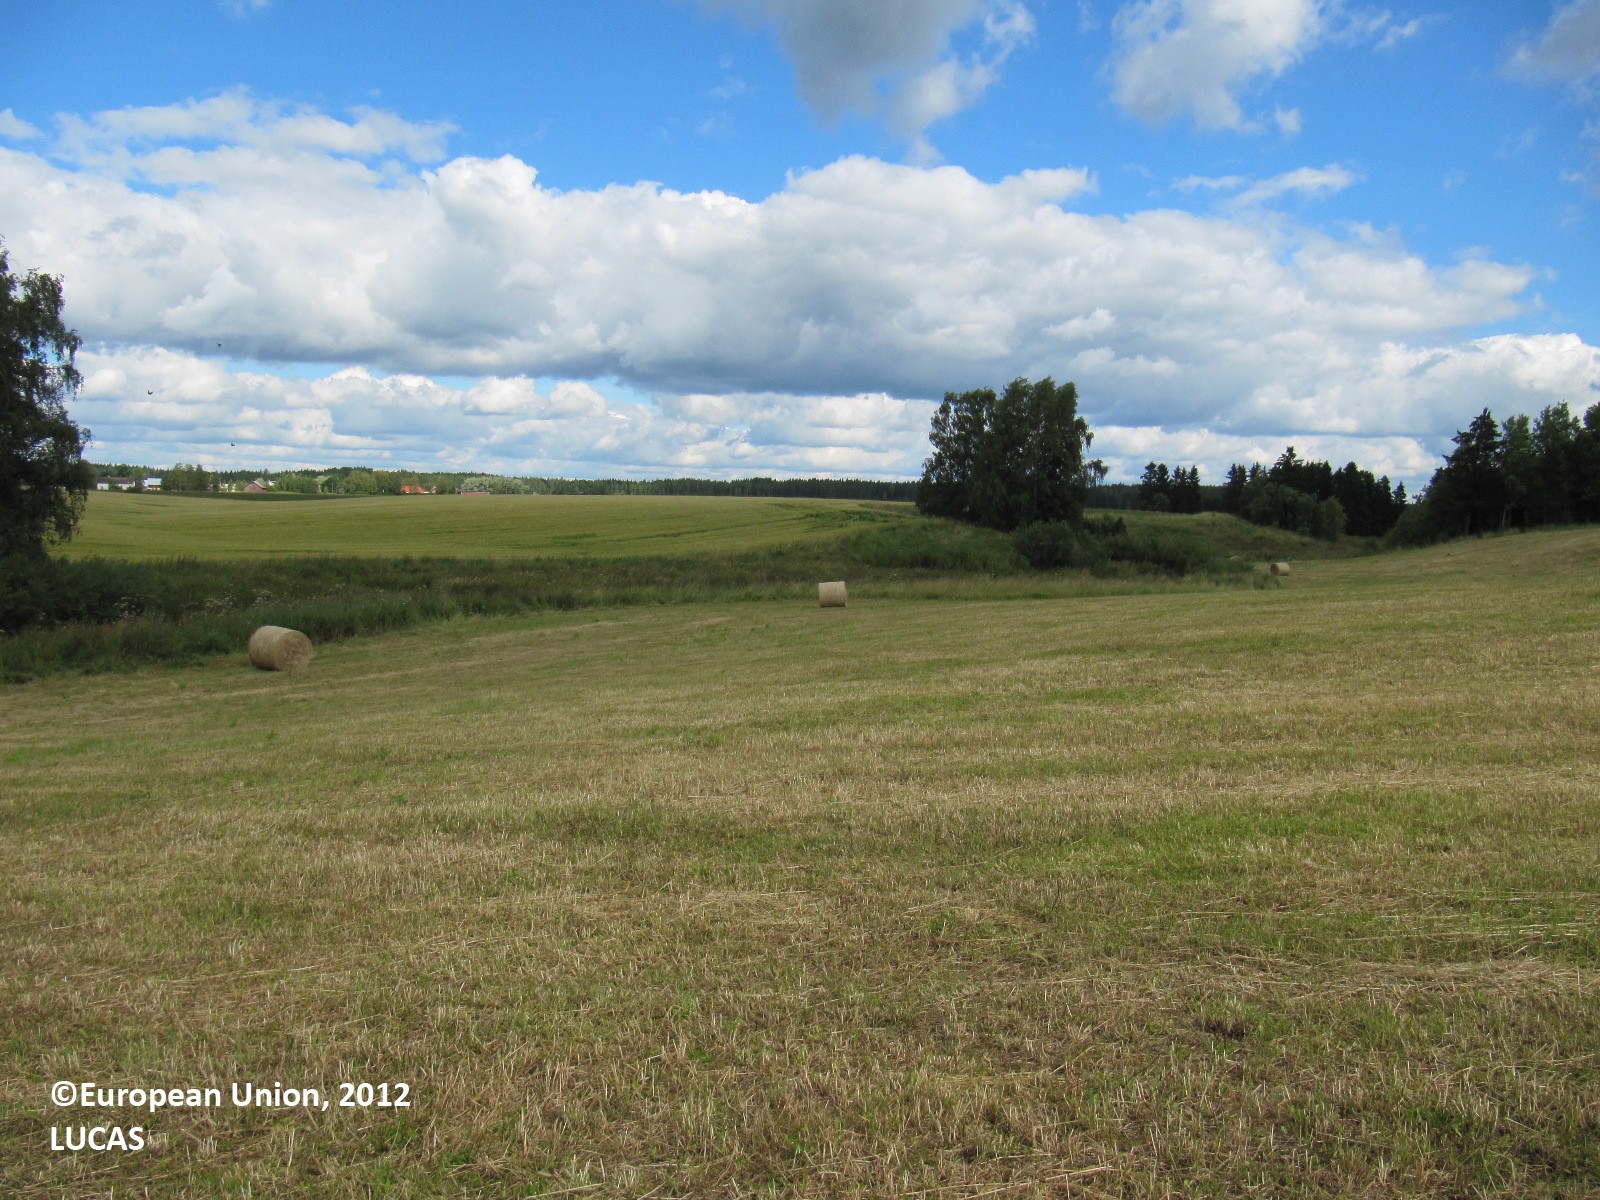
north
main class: Grassland
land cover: Grassland without tree/shrub cover
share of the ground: > 75 %
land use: Agriculture (excluding fallow land and kitchen gardens)
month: August
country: FI
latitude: 60.5389
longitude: 23.2606
